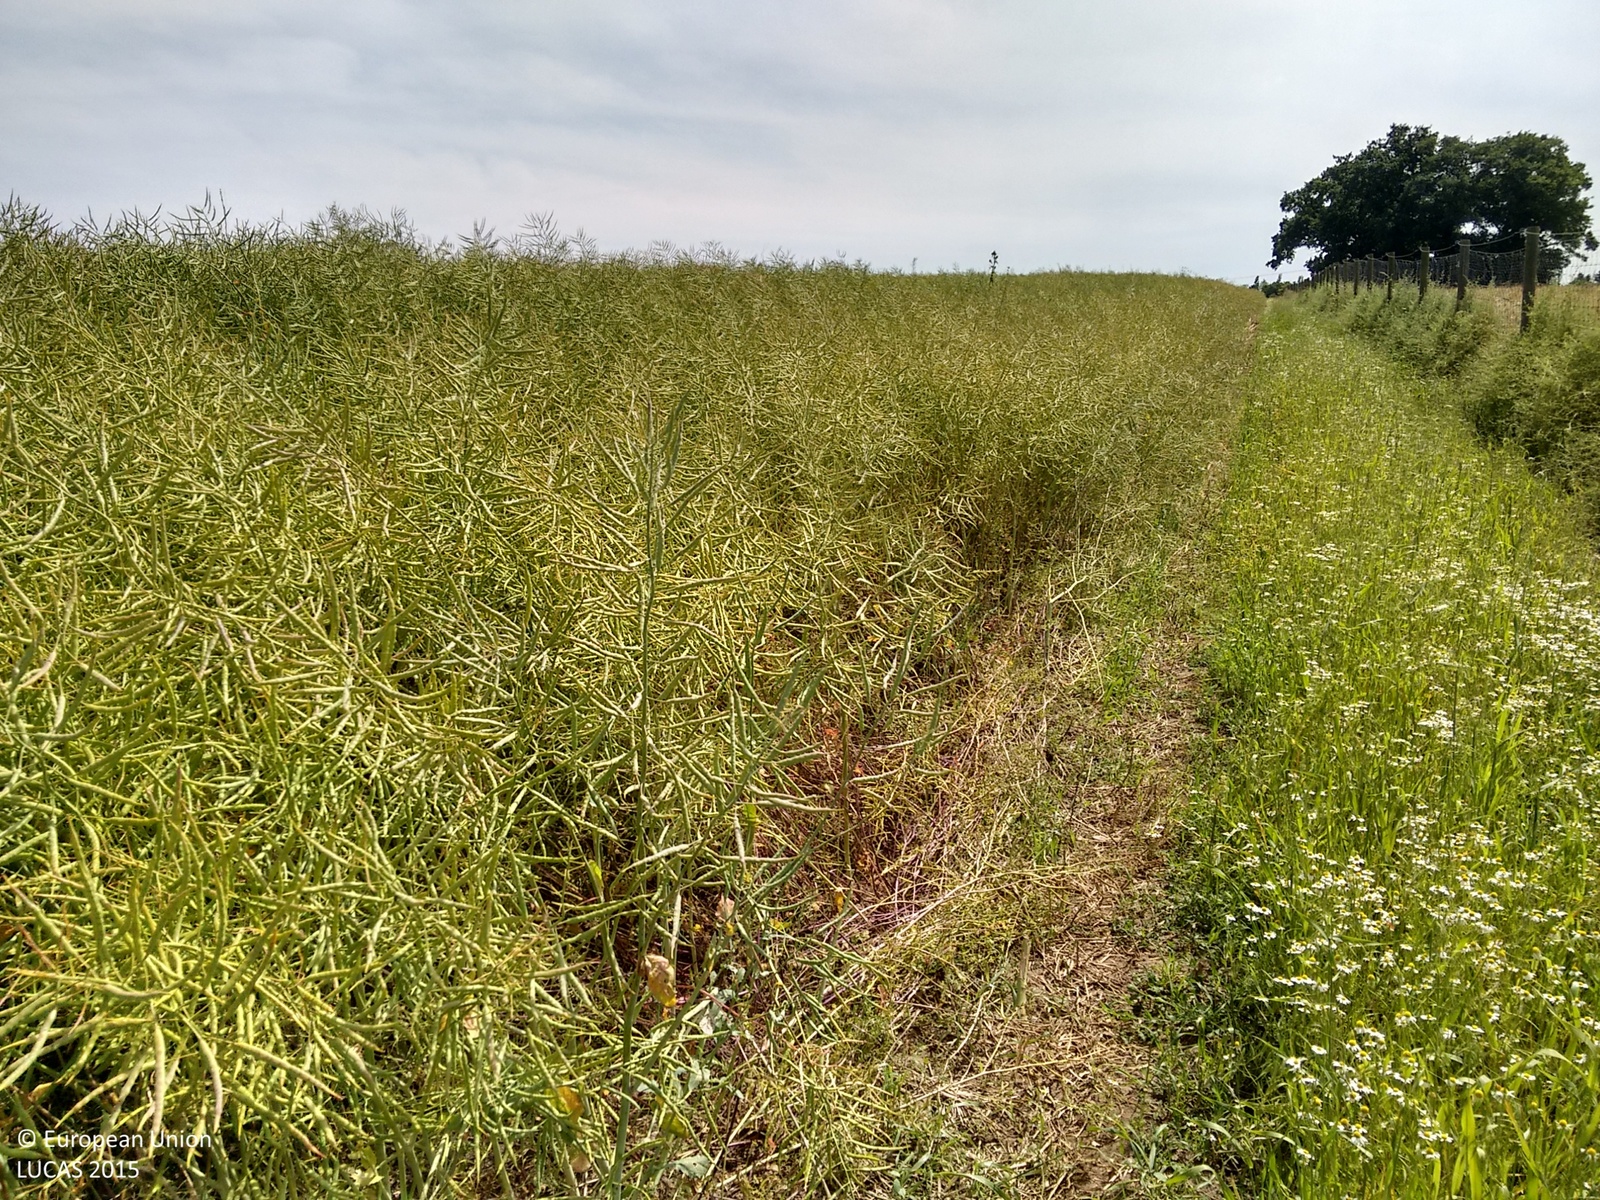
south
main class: Cropland
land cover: Rape and turnip rape
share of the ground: > 75 %
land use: Agriculture (excluding fallow land and kitchen gardens)
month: July
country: GB
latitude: 52.9319
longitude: -1.0386
